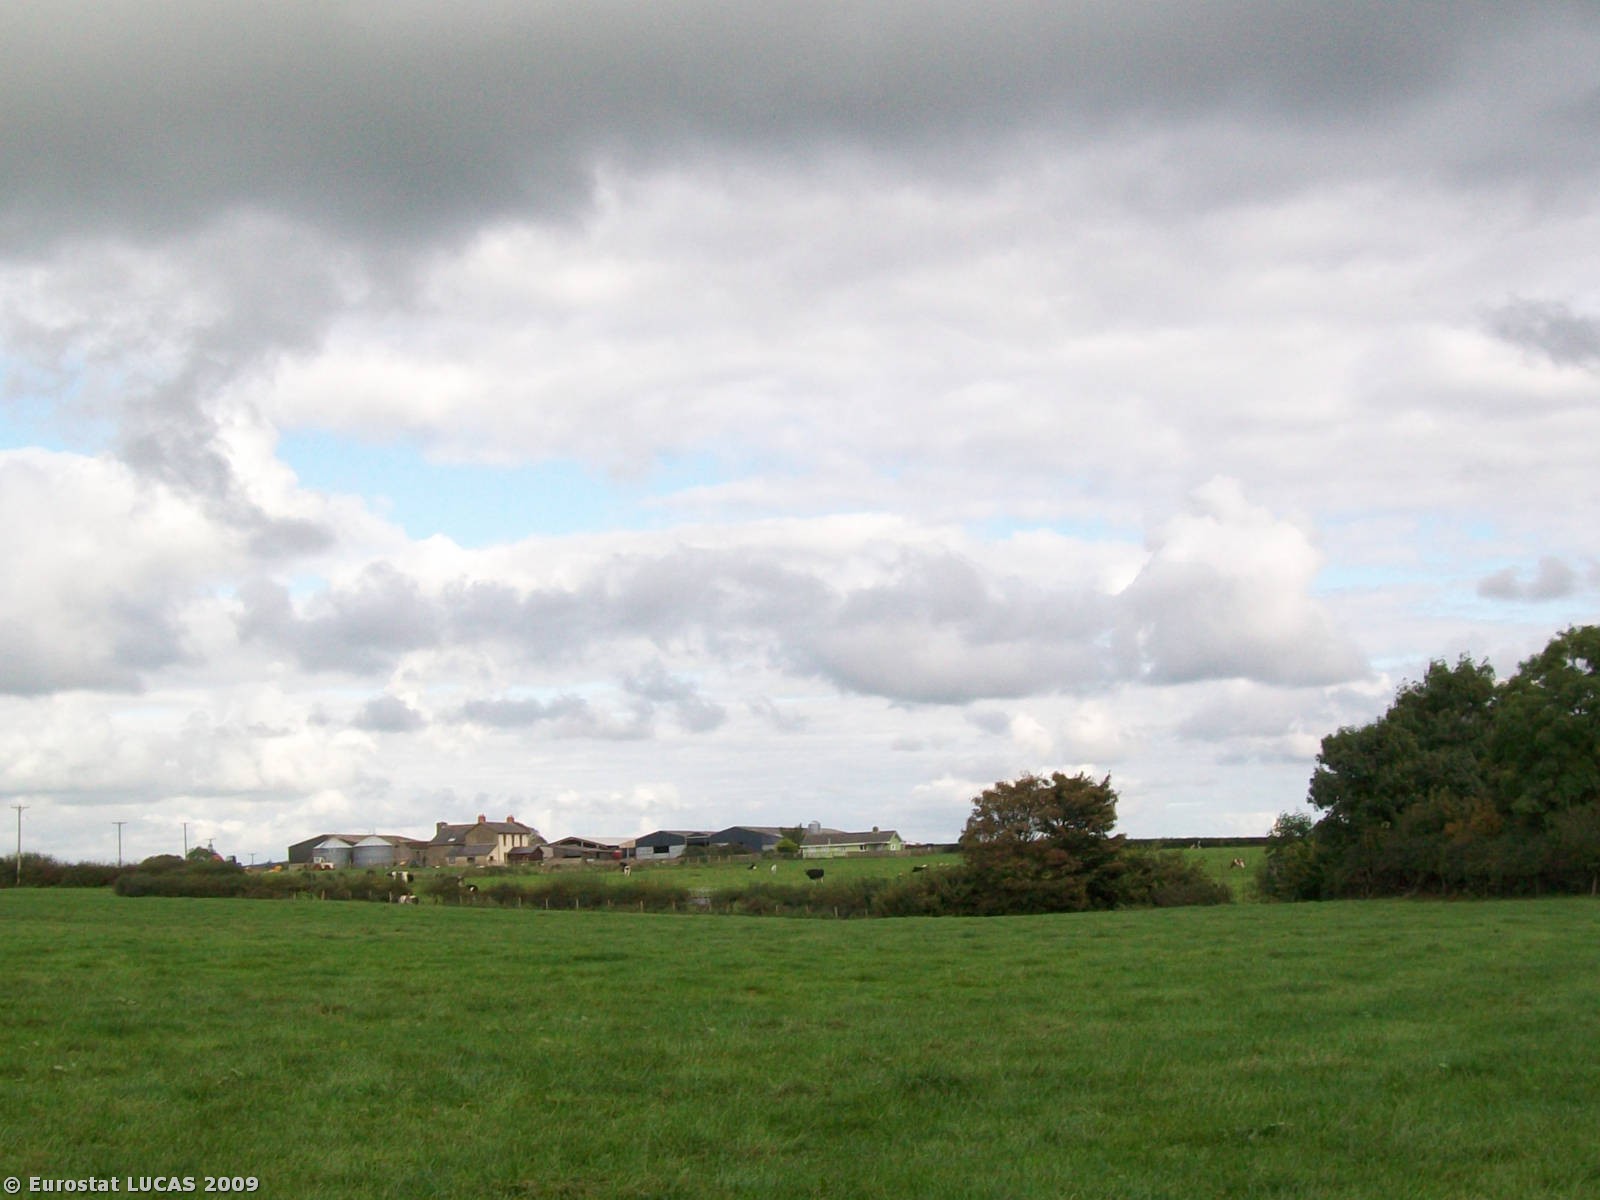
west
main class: Grassland
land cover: Grassland without tree/shrub cover
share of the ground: > 75 %
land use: Agriculture (excluding fallow land and kitchen gardens)
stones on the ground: < 10 %
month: October
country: GB
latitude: 51.8363
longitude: -4.7250
